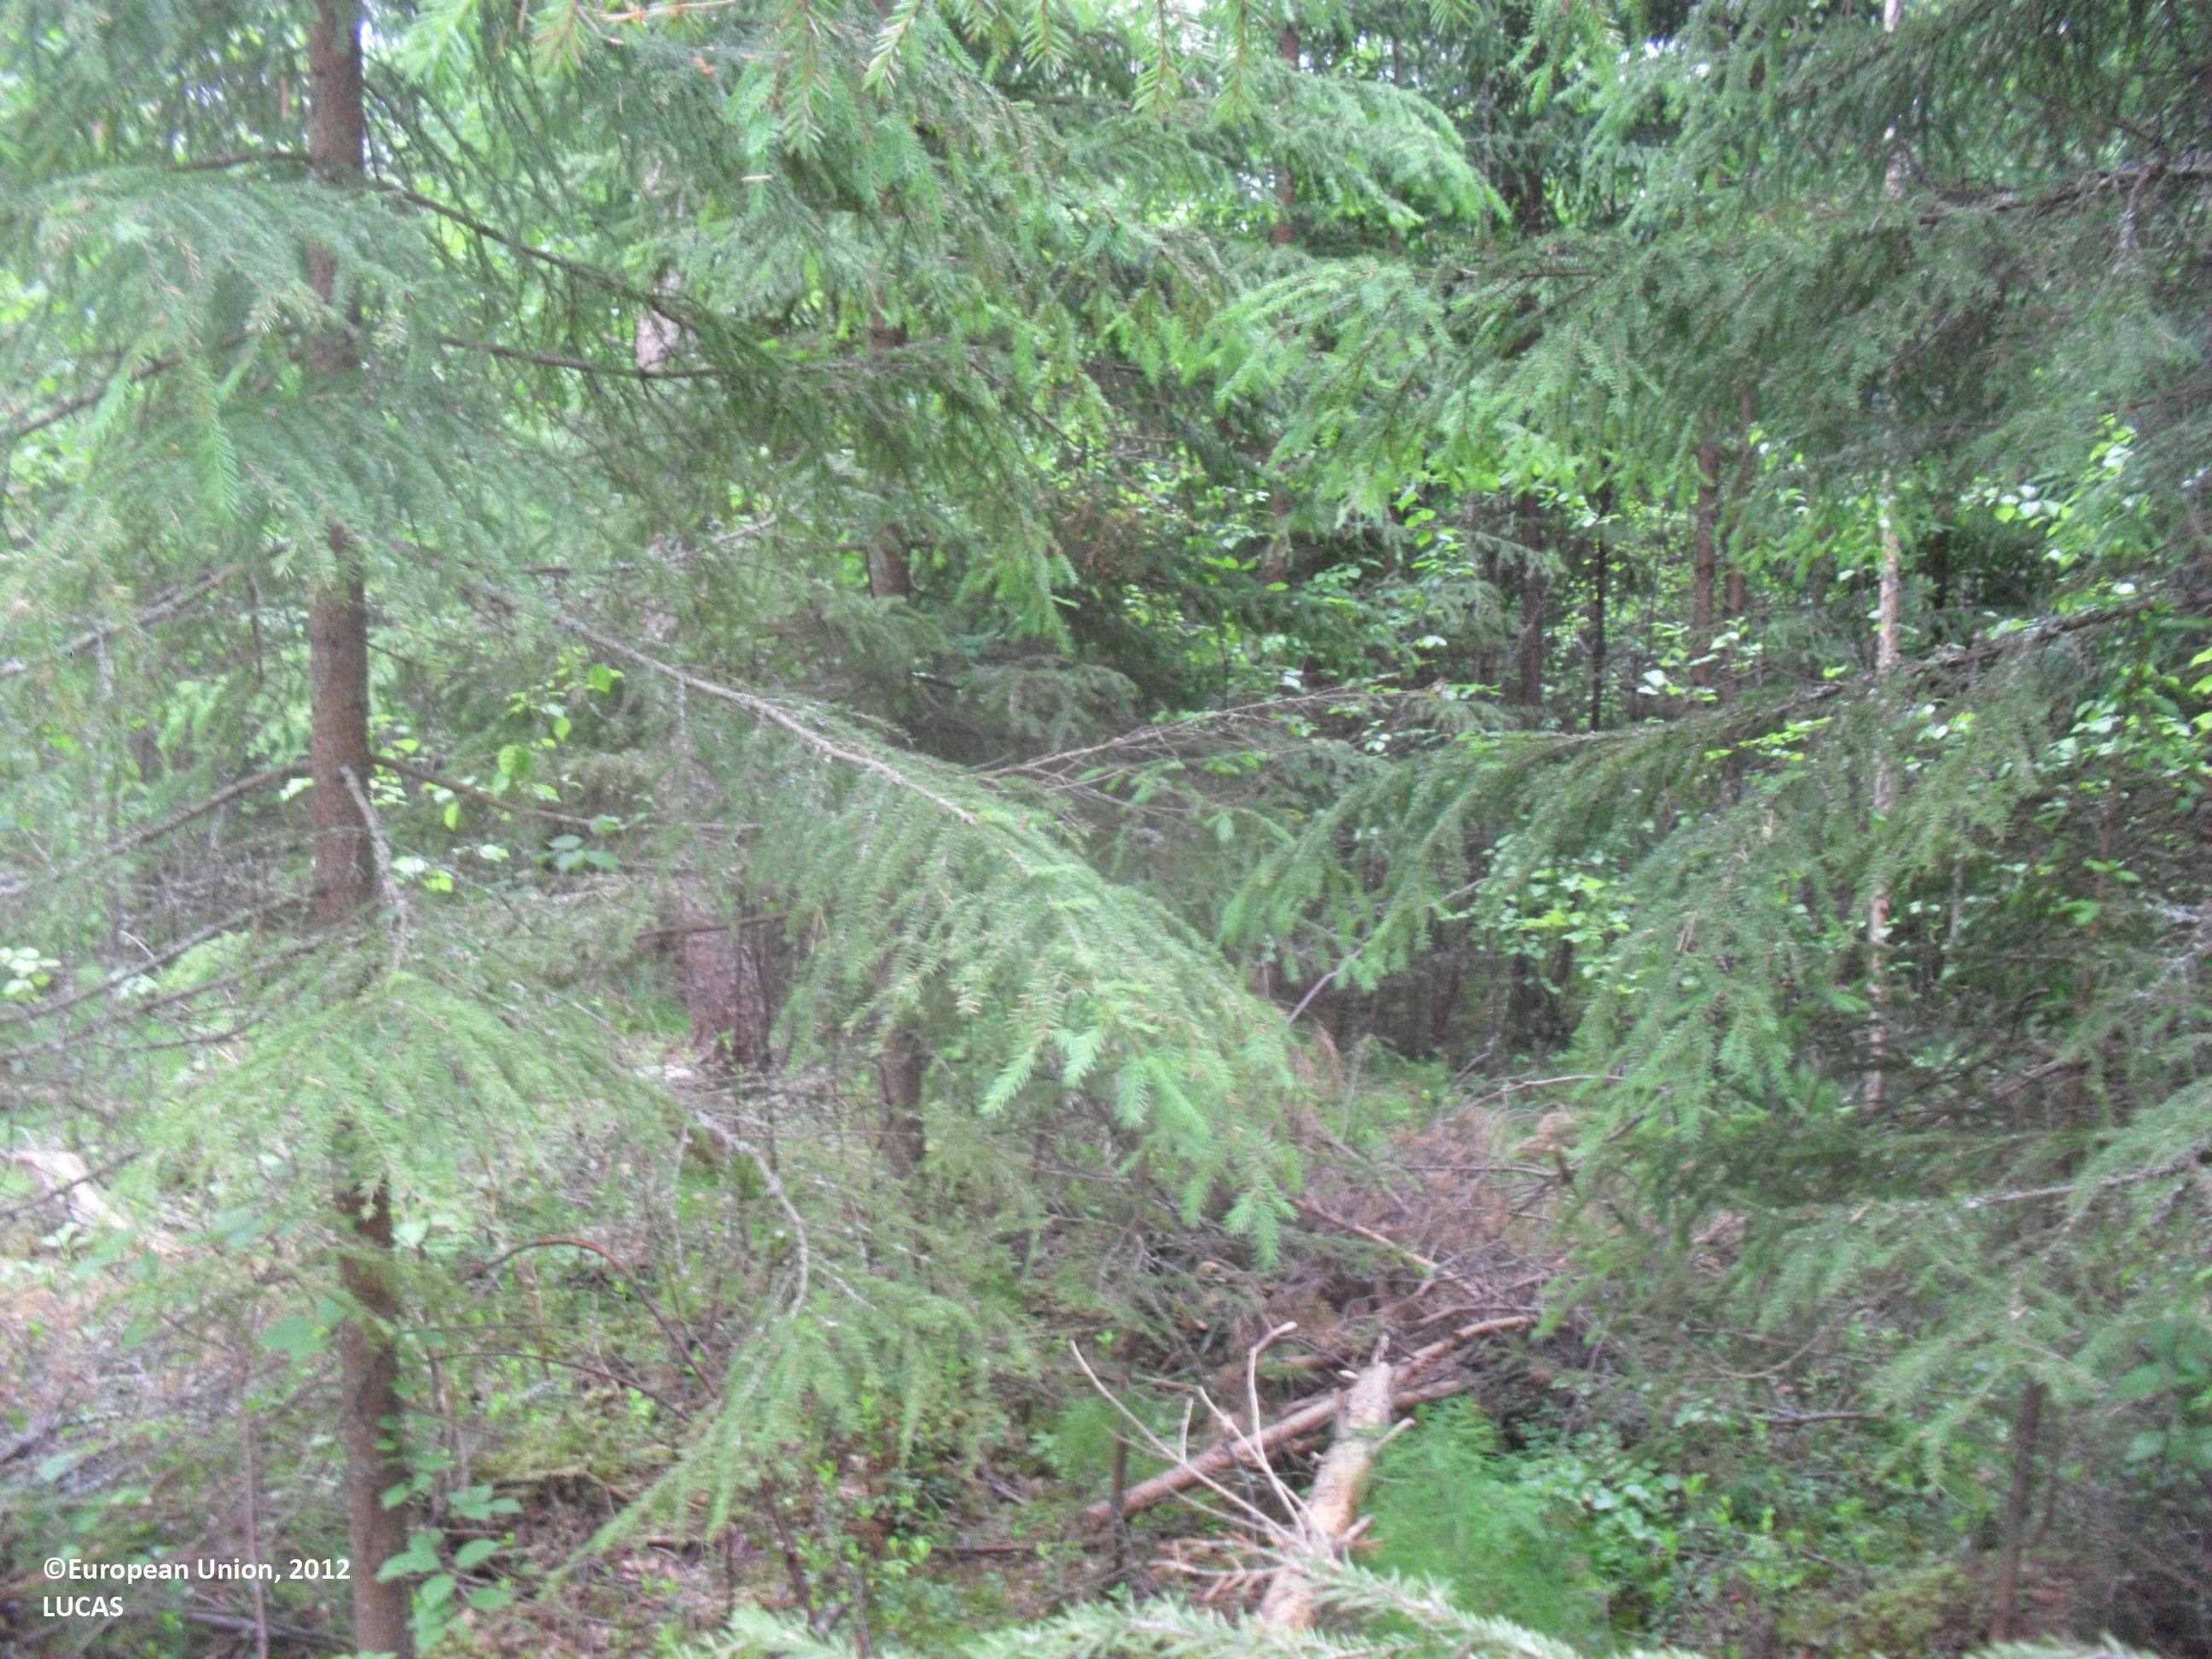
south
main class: Woodland
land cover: Other mixed woodland
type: boreal forest
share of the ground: 50 - 75 %
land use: Forestry
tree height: > 5 m
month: June
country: FI
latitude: 62.9804
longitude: 23.6237
